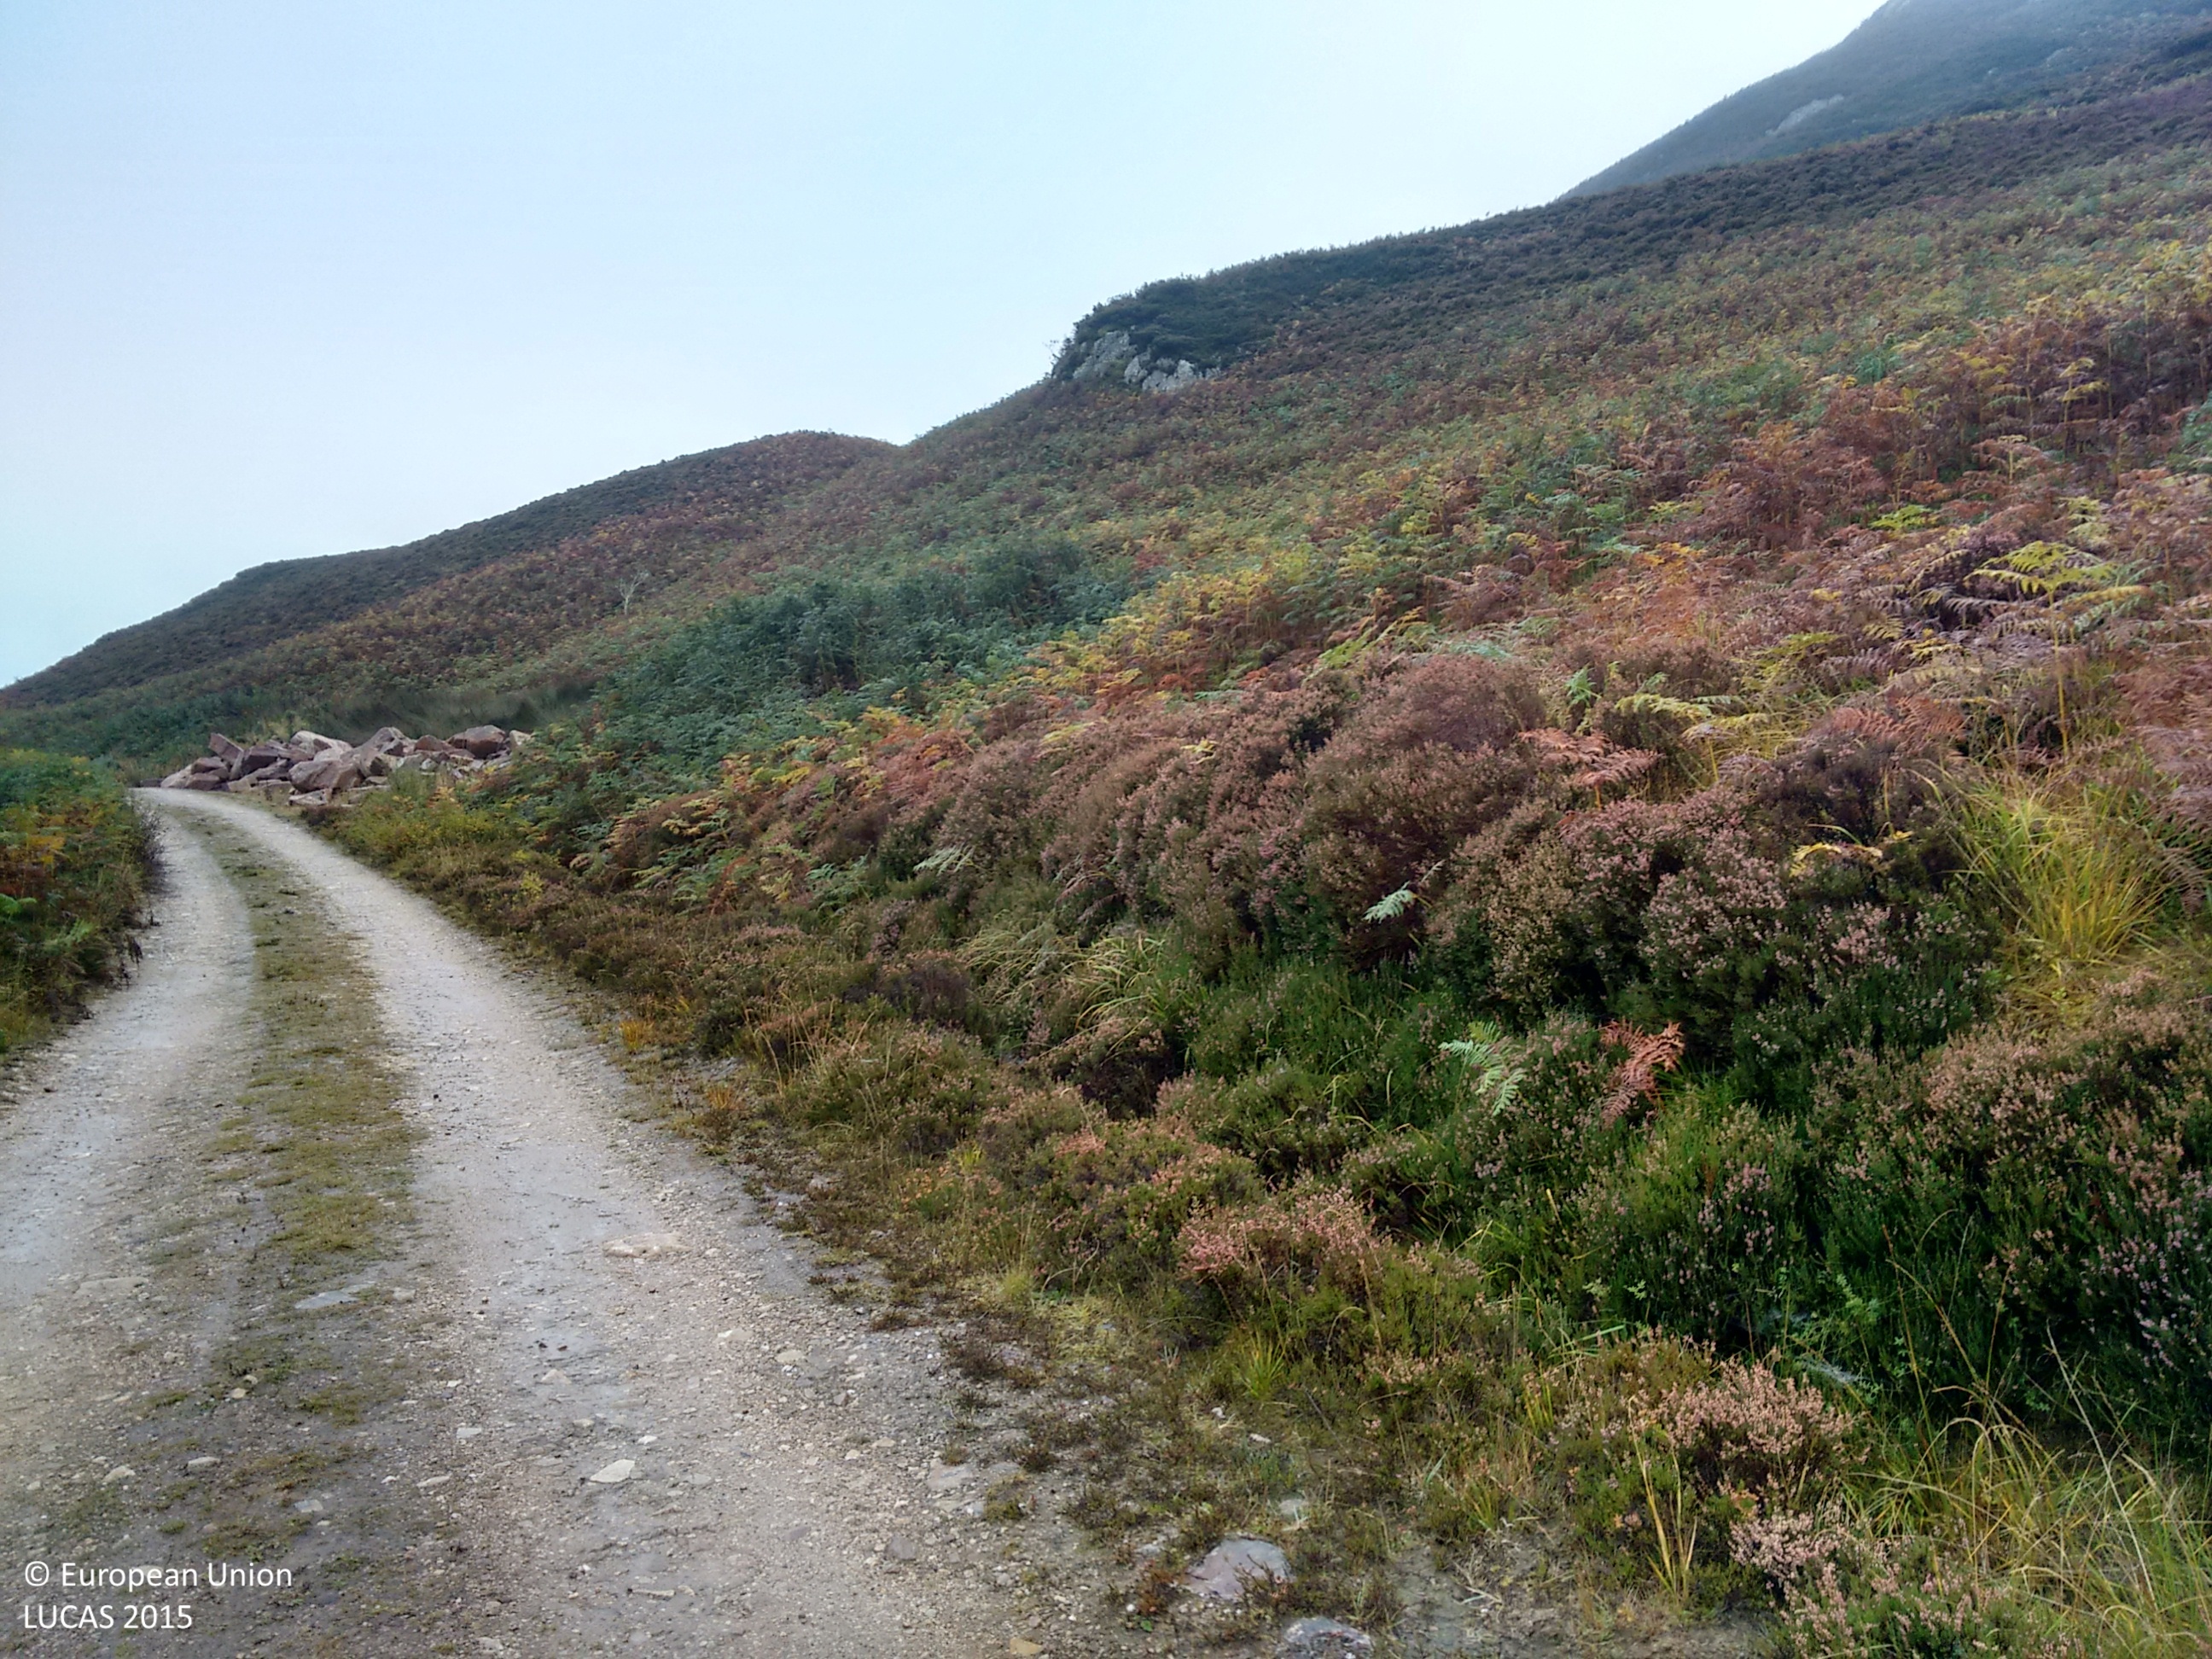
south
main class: Shrubland
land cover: Shrubland without tree cover
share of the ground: > 75 %
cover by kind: shrubs 80 %, herbaceous plants 20 %
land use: Semi-natural and natural areas not in use
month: October
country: GB
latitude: 55.6220
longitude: -6.2302
